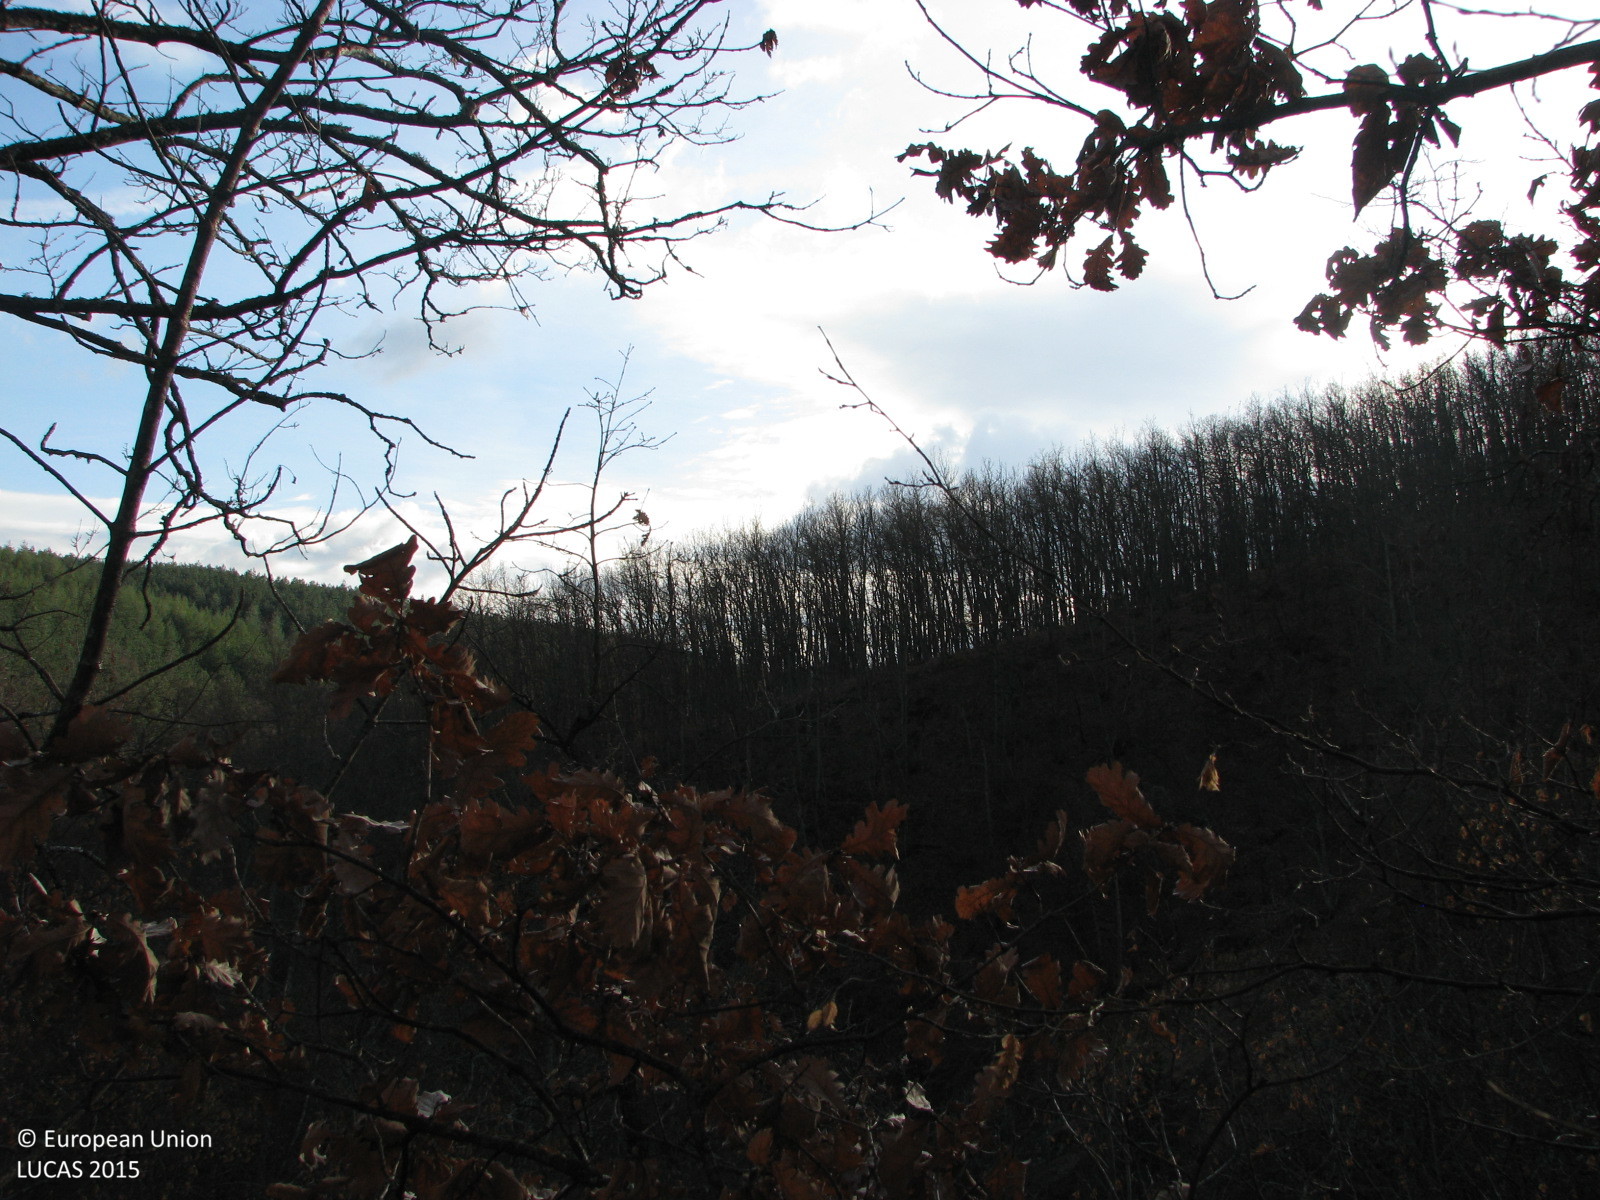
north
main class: Woodland
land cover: Broadleaved woodland
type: mesophytic deciduous forest
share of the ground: > 75 %
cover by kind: broadleaved forest trees 85 %, unconsolidated bare surface 15 %
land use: Forestry
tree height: < 5 m
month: December
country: BG
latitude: 42.4592
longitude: 24.2870
